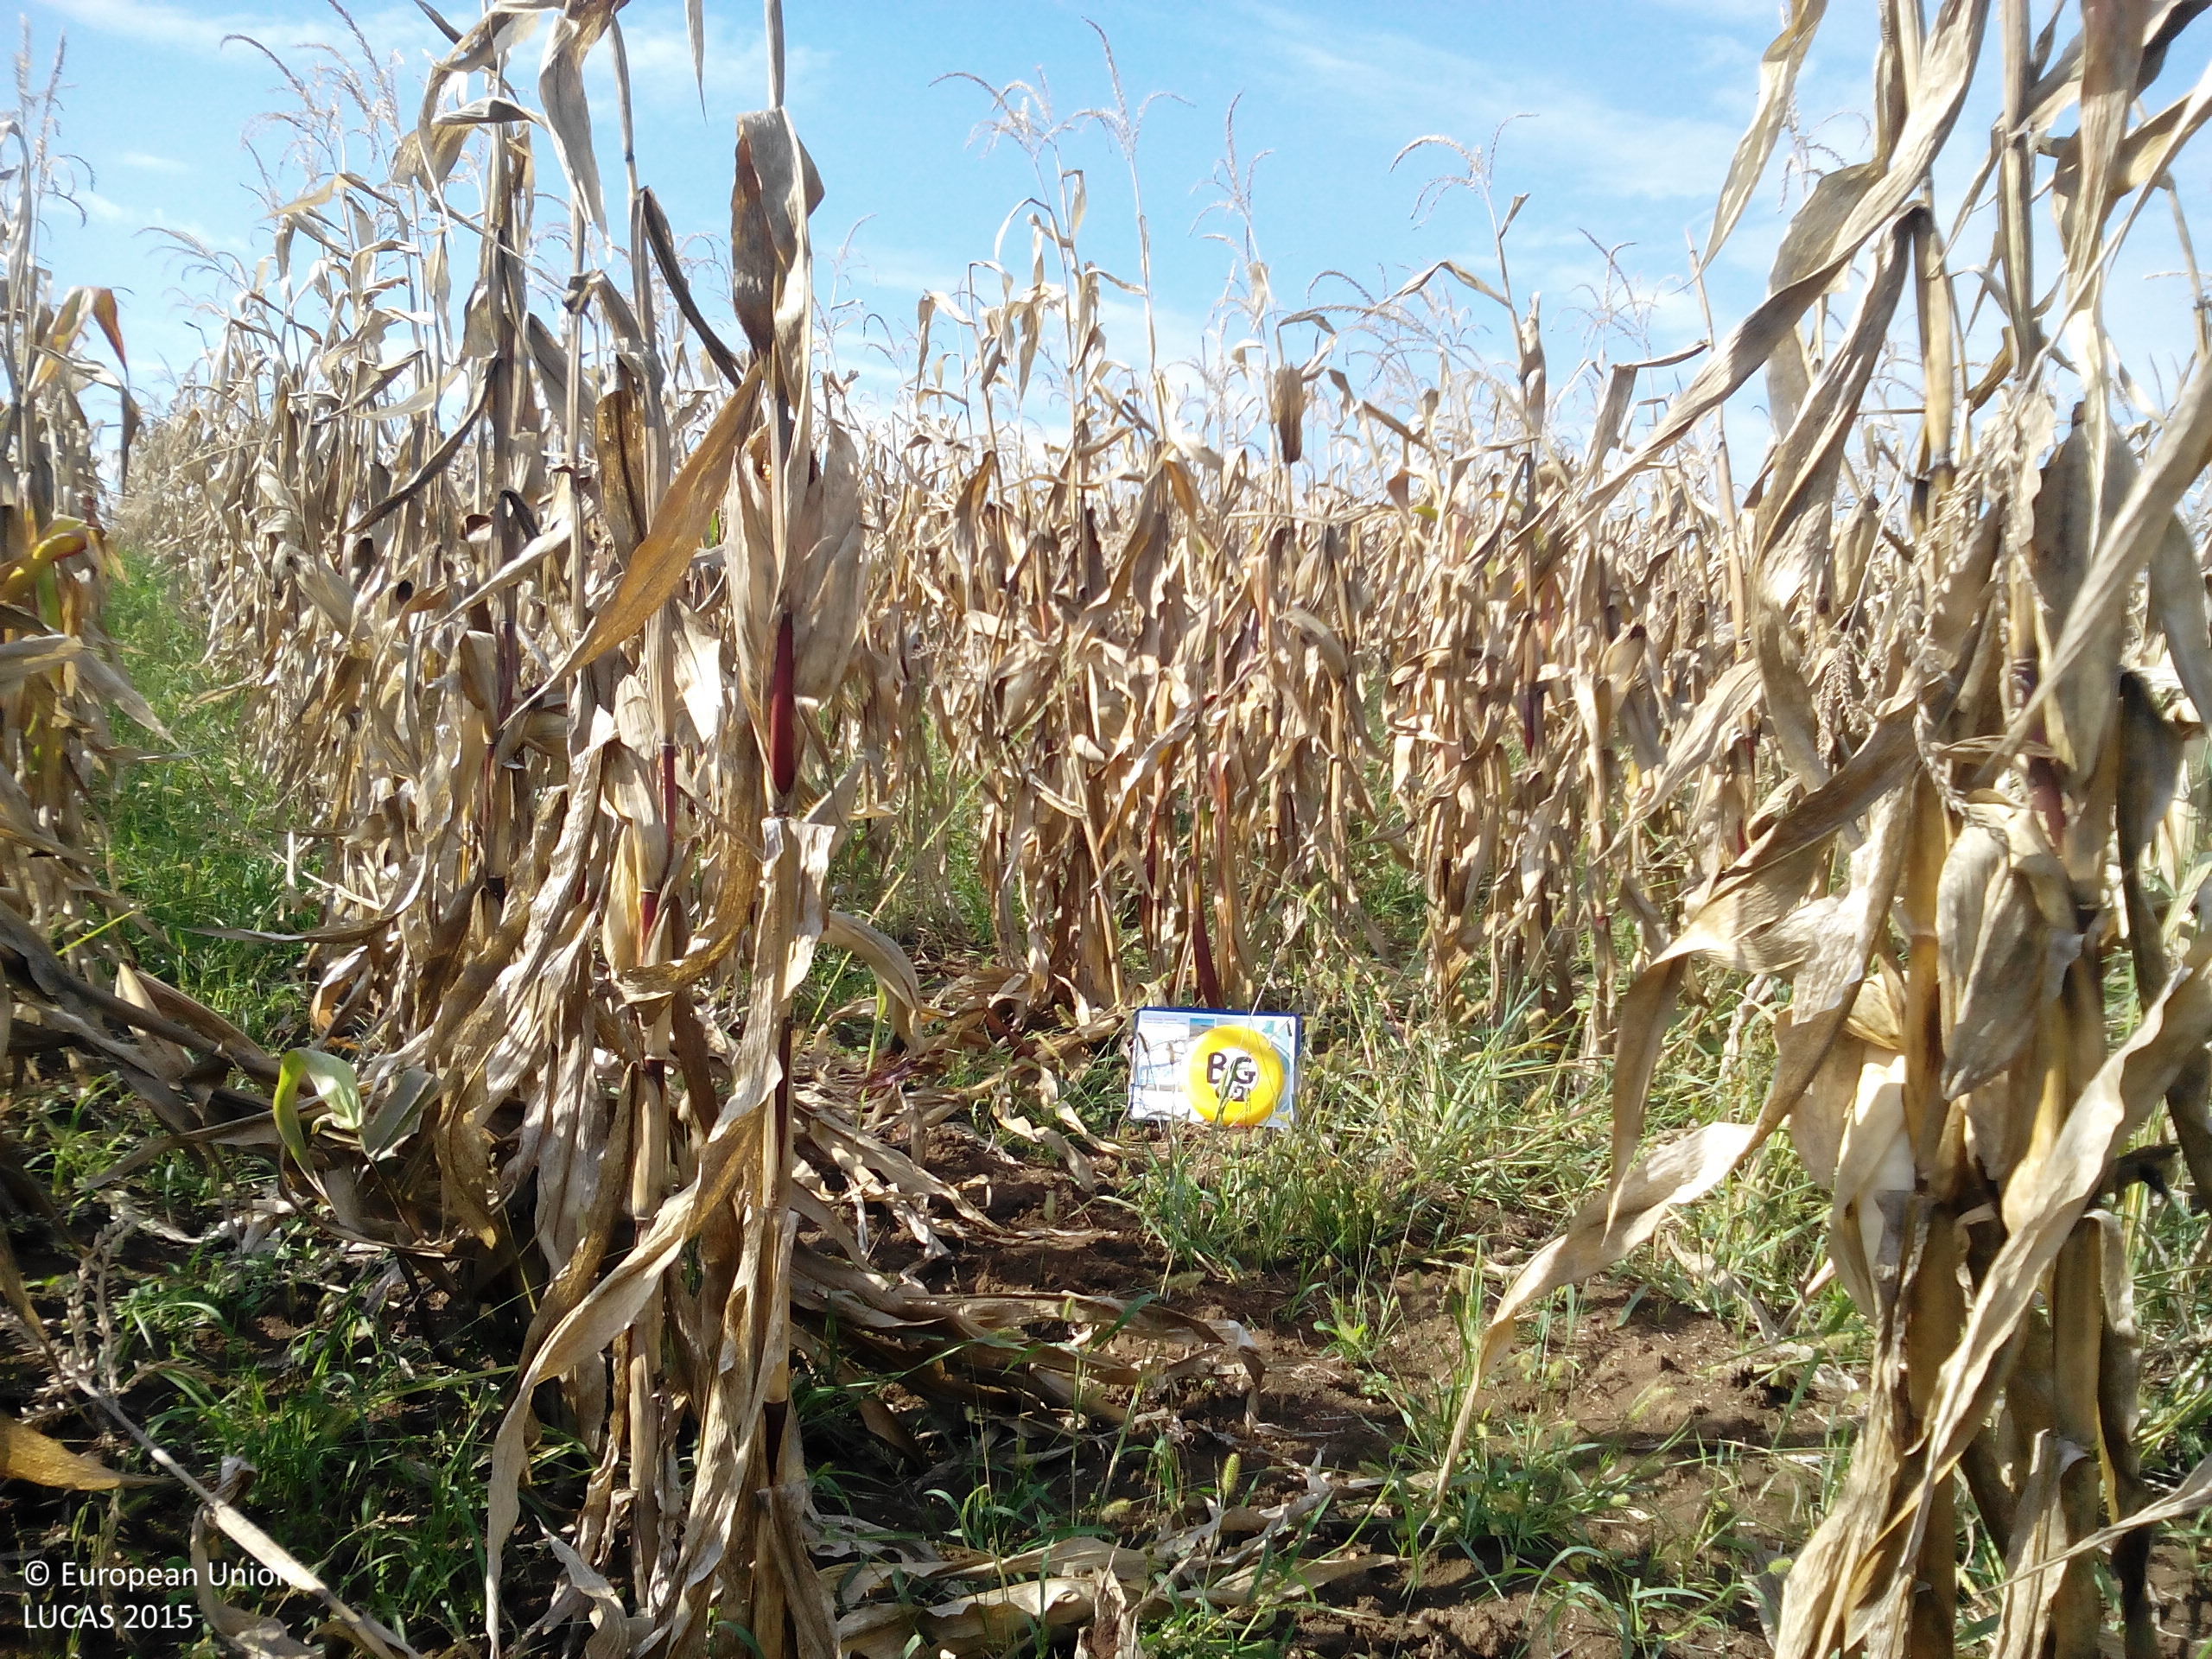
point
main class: Cropland
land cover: Maize
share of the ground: > 75 %
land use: Agriculture (excluding fallow land and kitchen gardens)
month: October
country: BG
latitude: 43.3485
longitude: 23.6781
